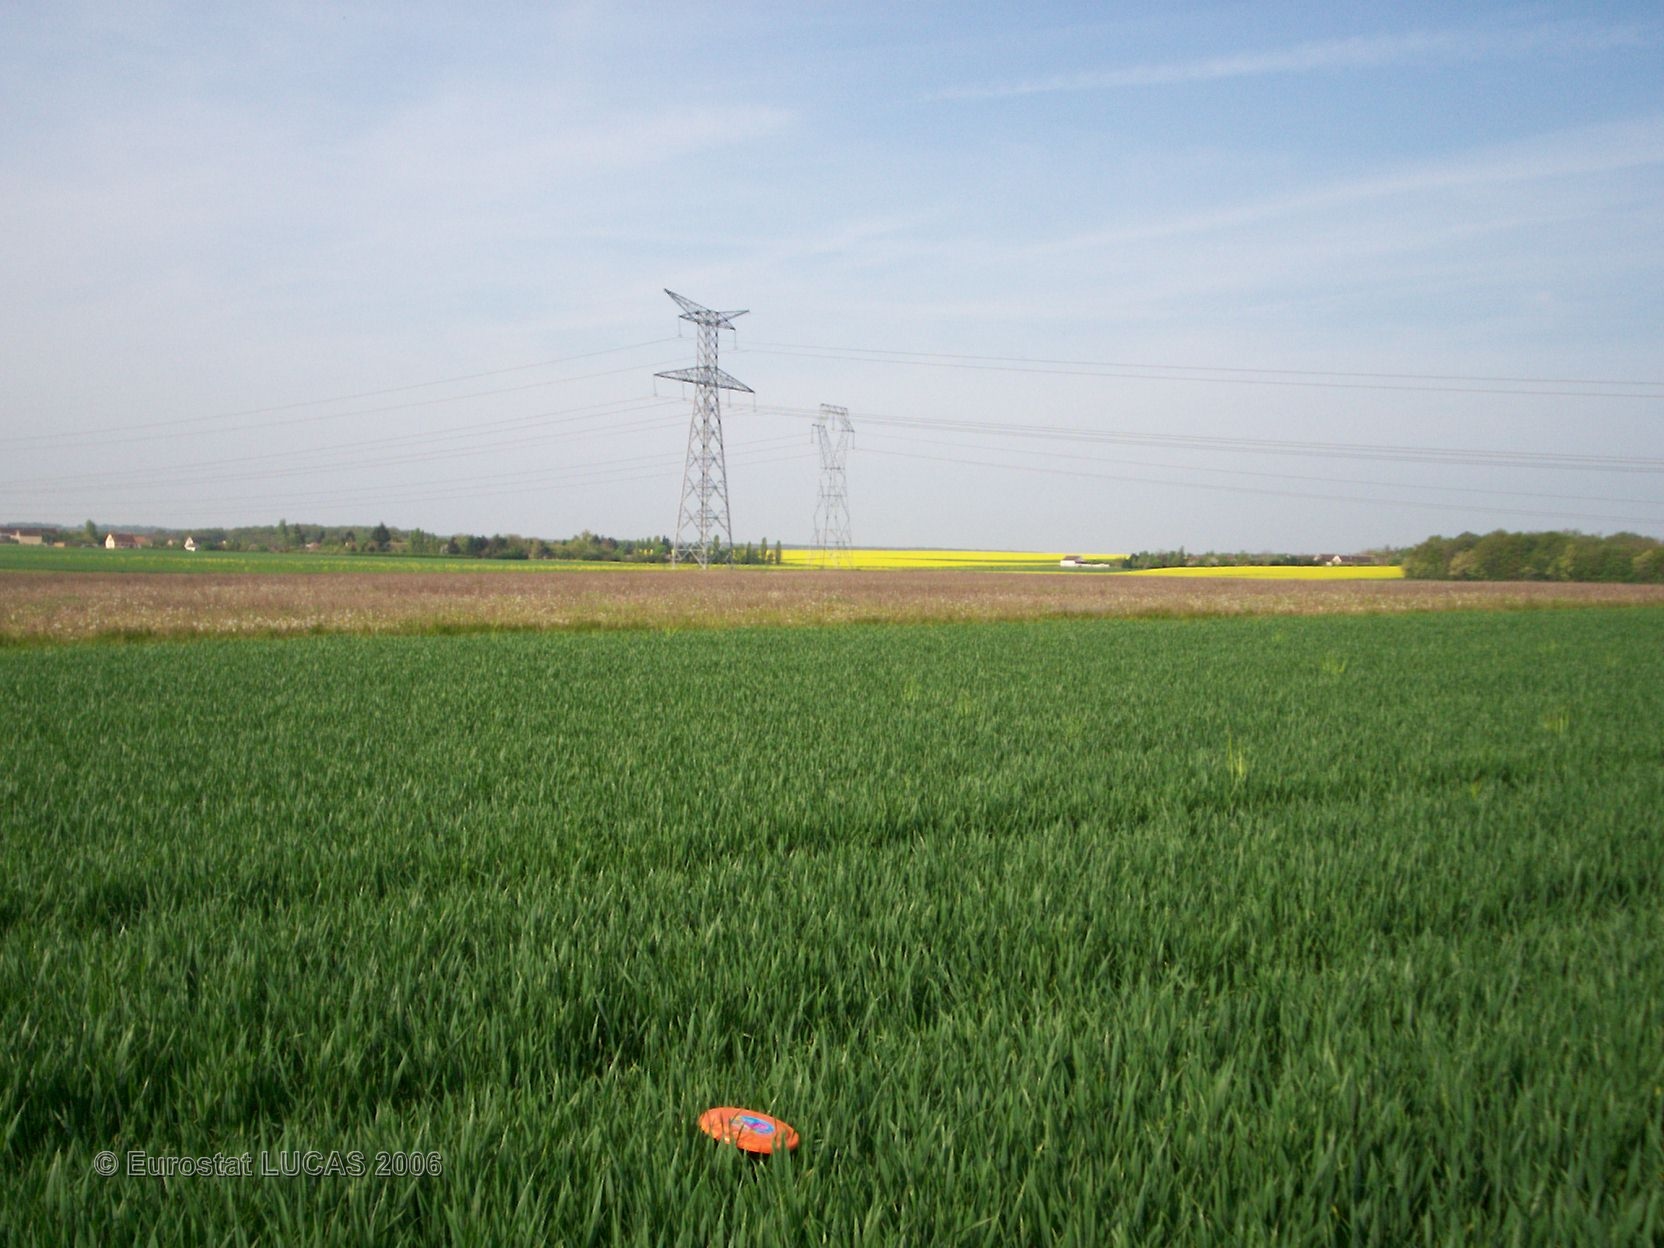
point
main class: Cropland
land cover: Common wheat
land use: Agriculture (excluding fallow land and kitchen gardens)
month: May
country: FR
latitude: 48.1004
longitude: 2.8615
